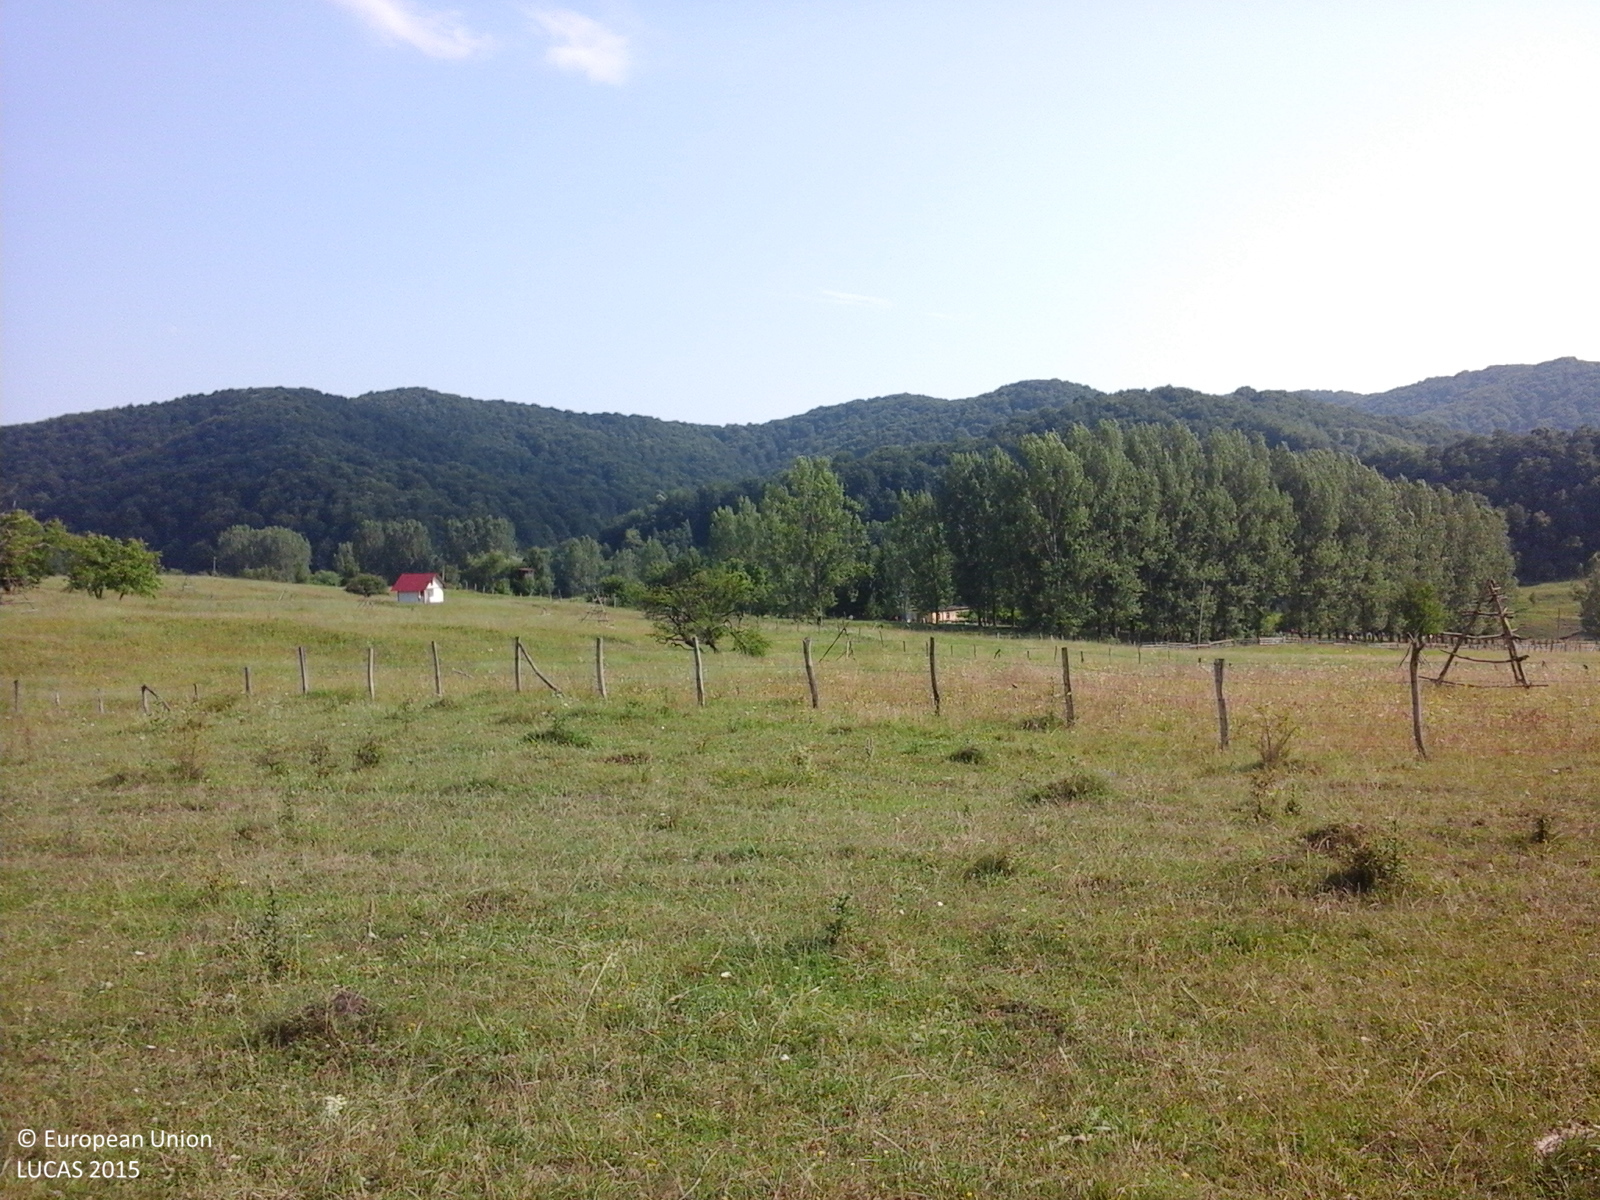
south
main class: Grassland
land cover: Grassland without tree/shrub cover
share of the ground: > 75 %
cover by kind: herbaceous plants 100 %
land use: Agriculture (excluding fallow land and kitchen gardens)
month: July
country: RO
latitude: 45.1783
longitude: 24.7284
